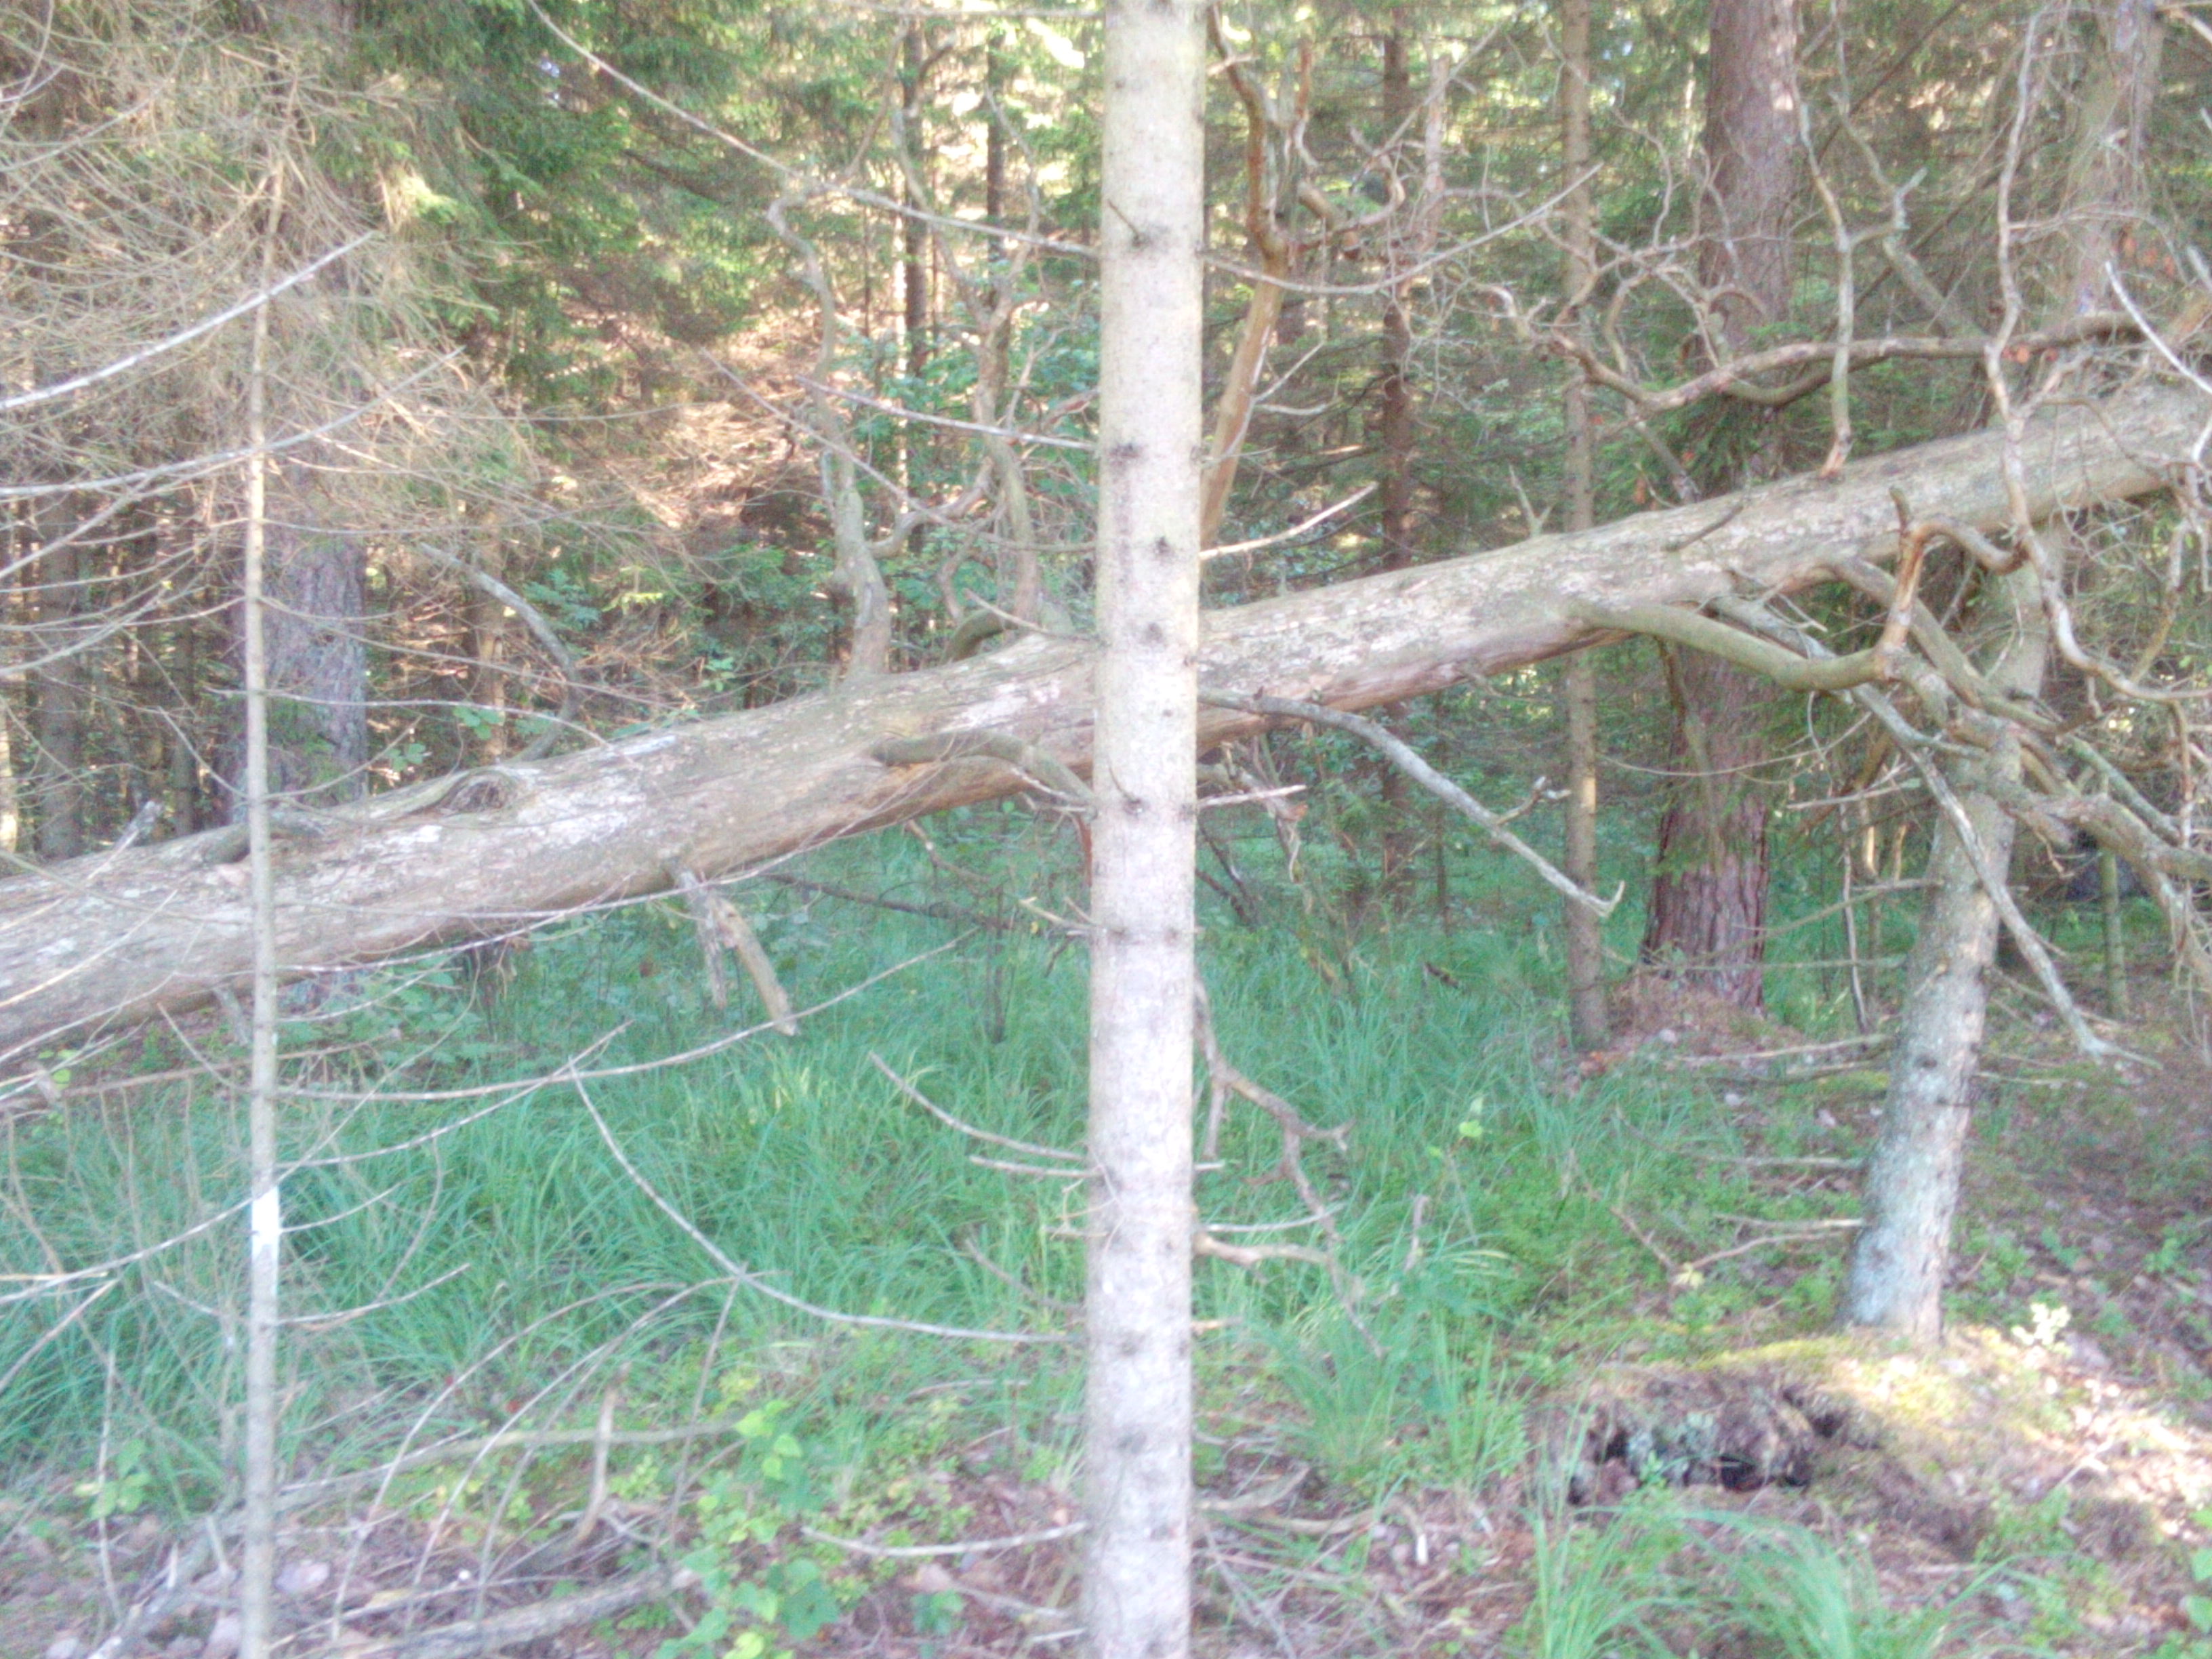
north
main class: Woodland
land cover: Spruce dominated coniferous woodland
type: hemiboreal forest and nemoral coniferous forest and mixed broadleaved-coniferous forest
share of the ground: > 75 %
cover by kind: coniferous forest trees 80 %, herbaceous plants 10 %, broadleaved forest trees 5 %, lichens and mosses 5 %
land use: Forestry
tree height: > 5 m
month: August
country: LV
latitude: 56.4545
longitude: 21.2512
